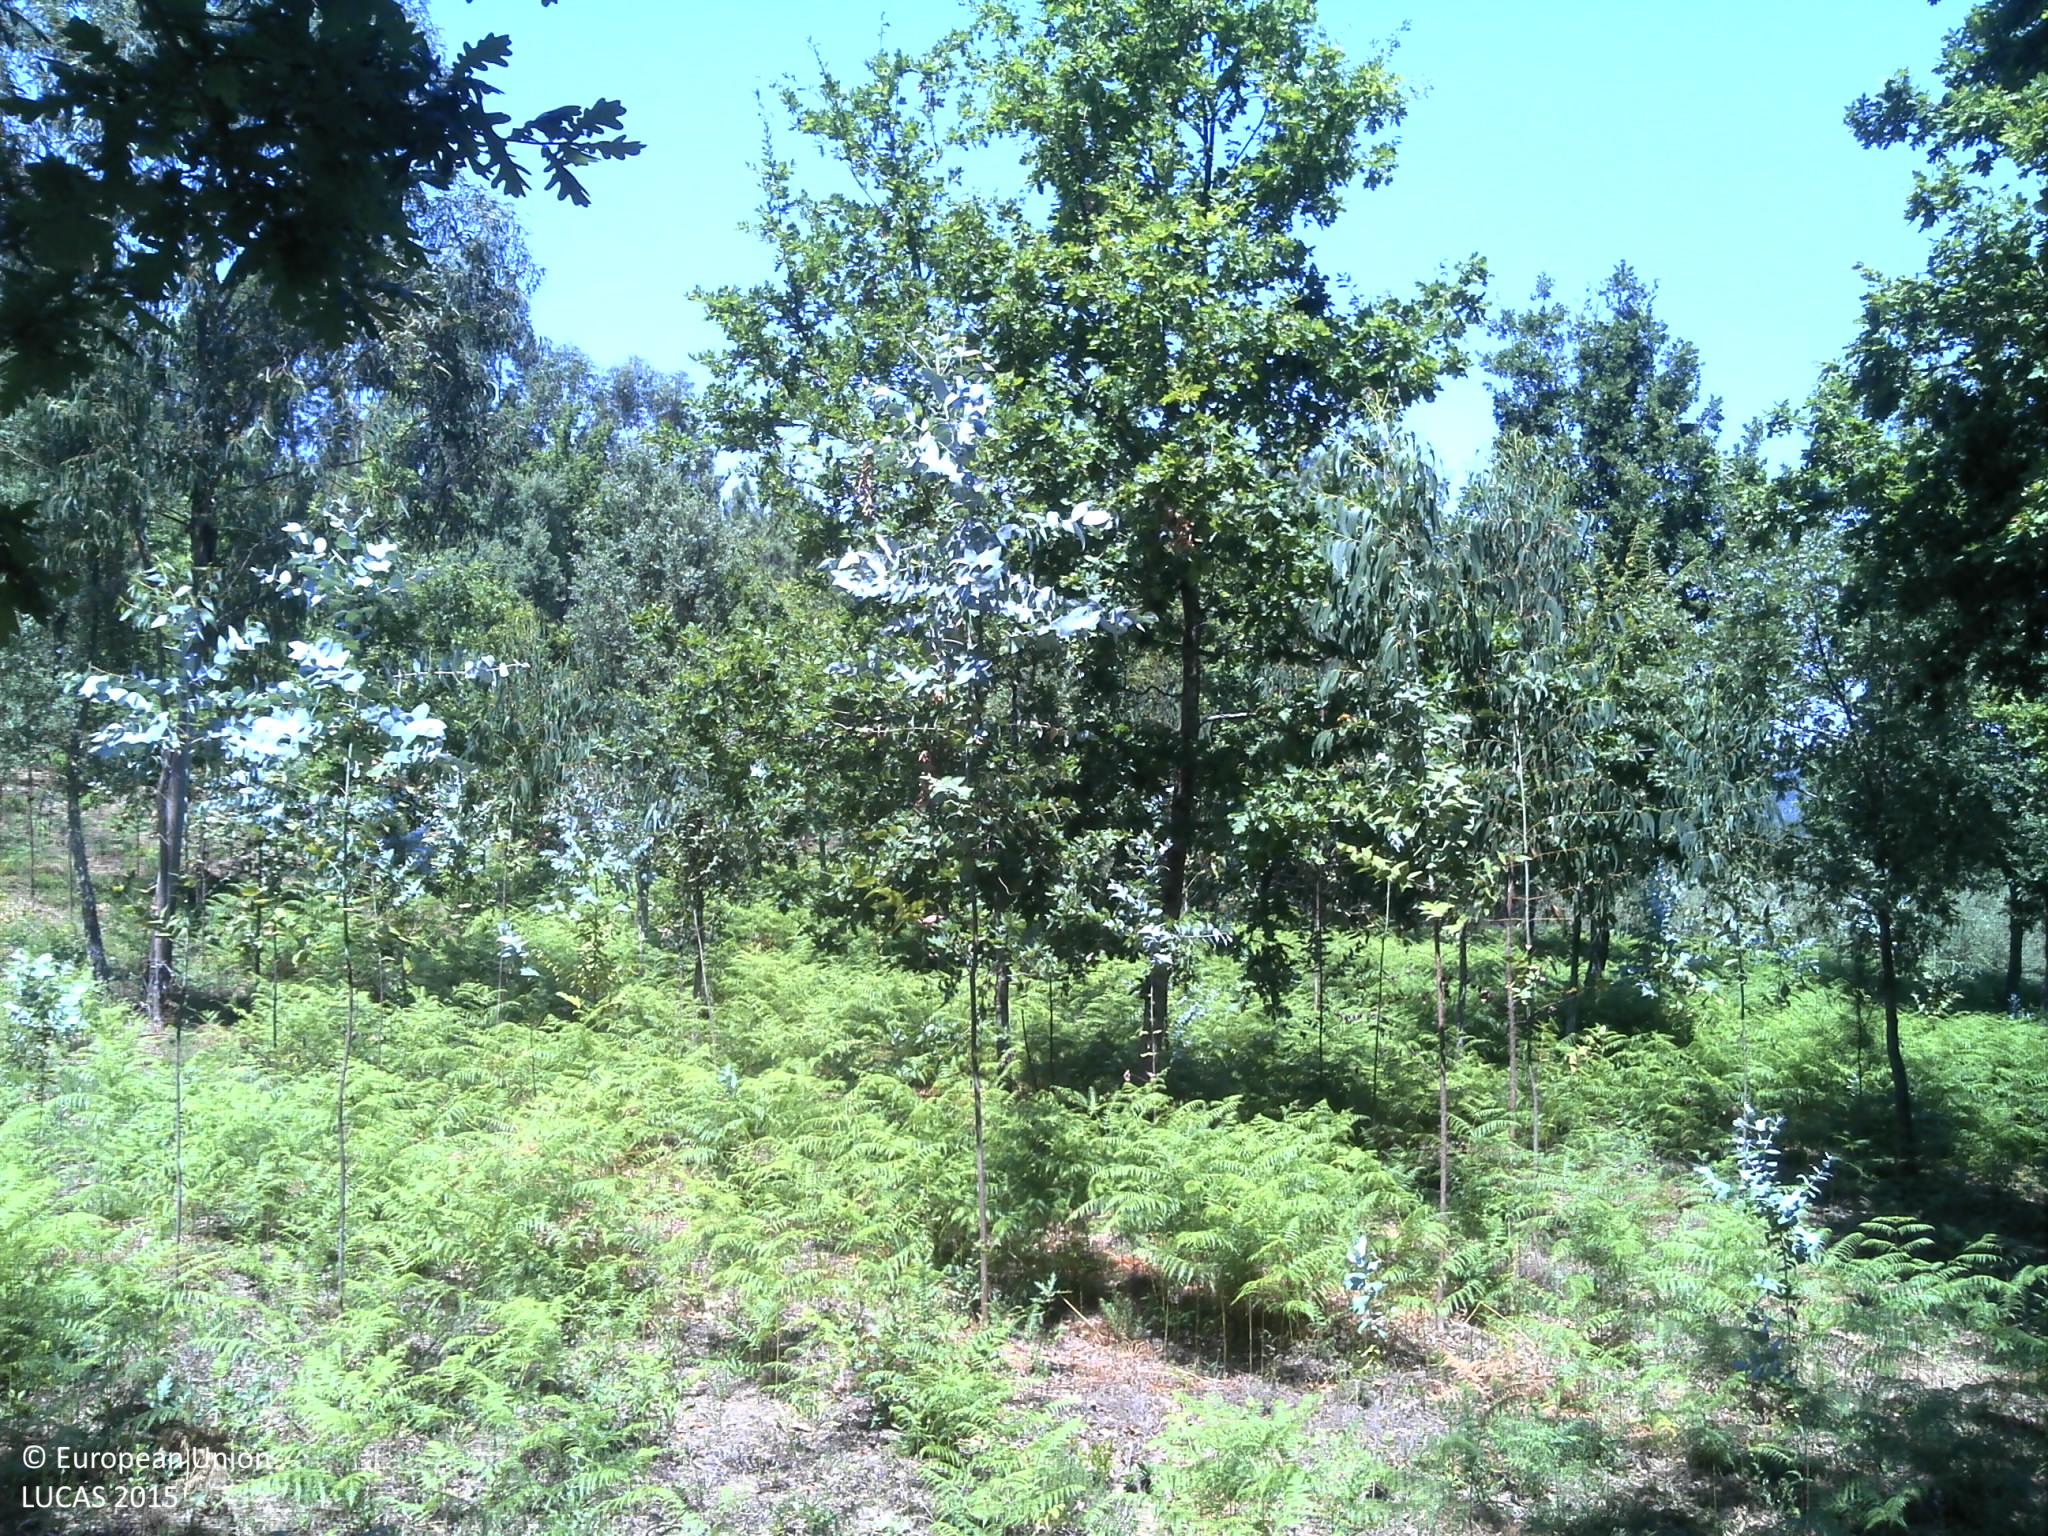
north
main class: Woodland
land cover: Broadleaved woodland
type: thermophilous deciduous forest
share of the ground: 50 - 75 %
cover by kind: broadleaved forest trees 70 %, shrubs 15 %, unconsolidated bare surface 15 %
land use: Forestry
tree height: > 5 m
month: July
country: PT
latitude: 40.3503
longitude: -7.9573
